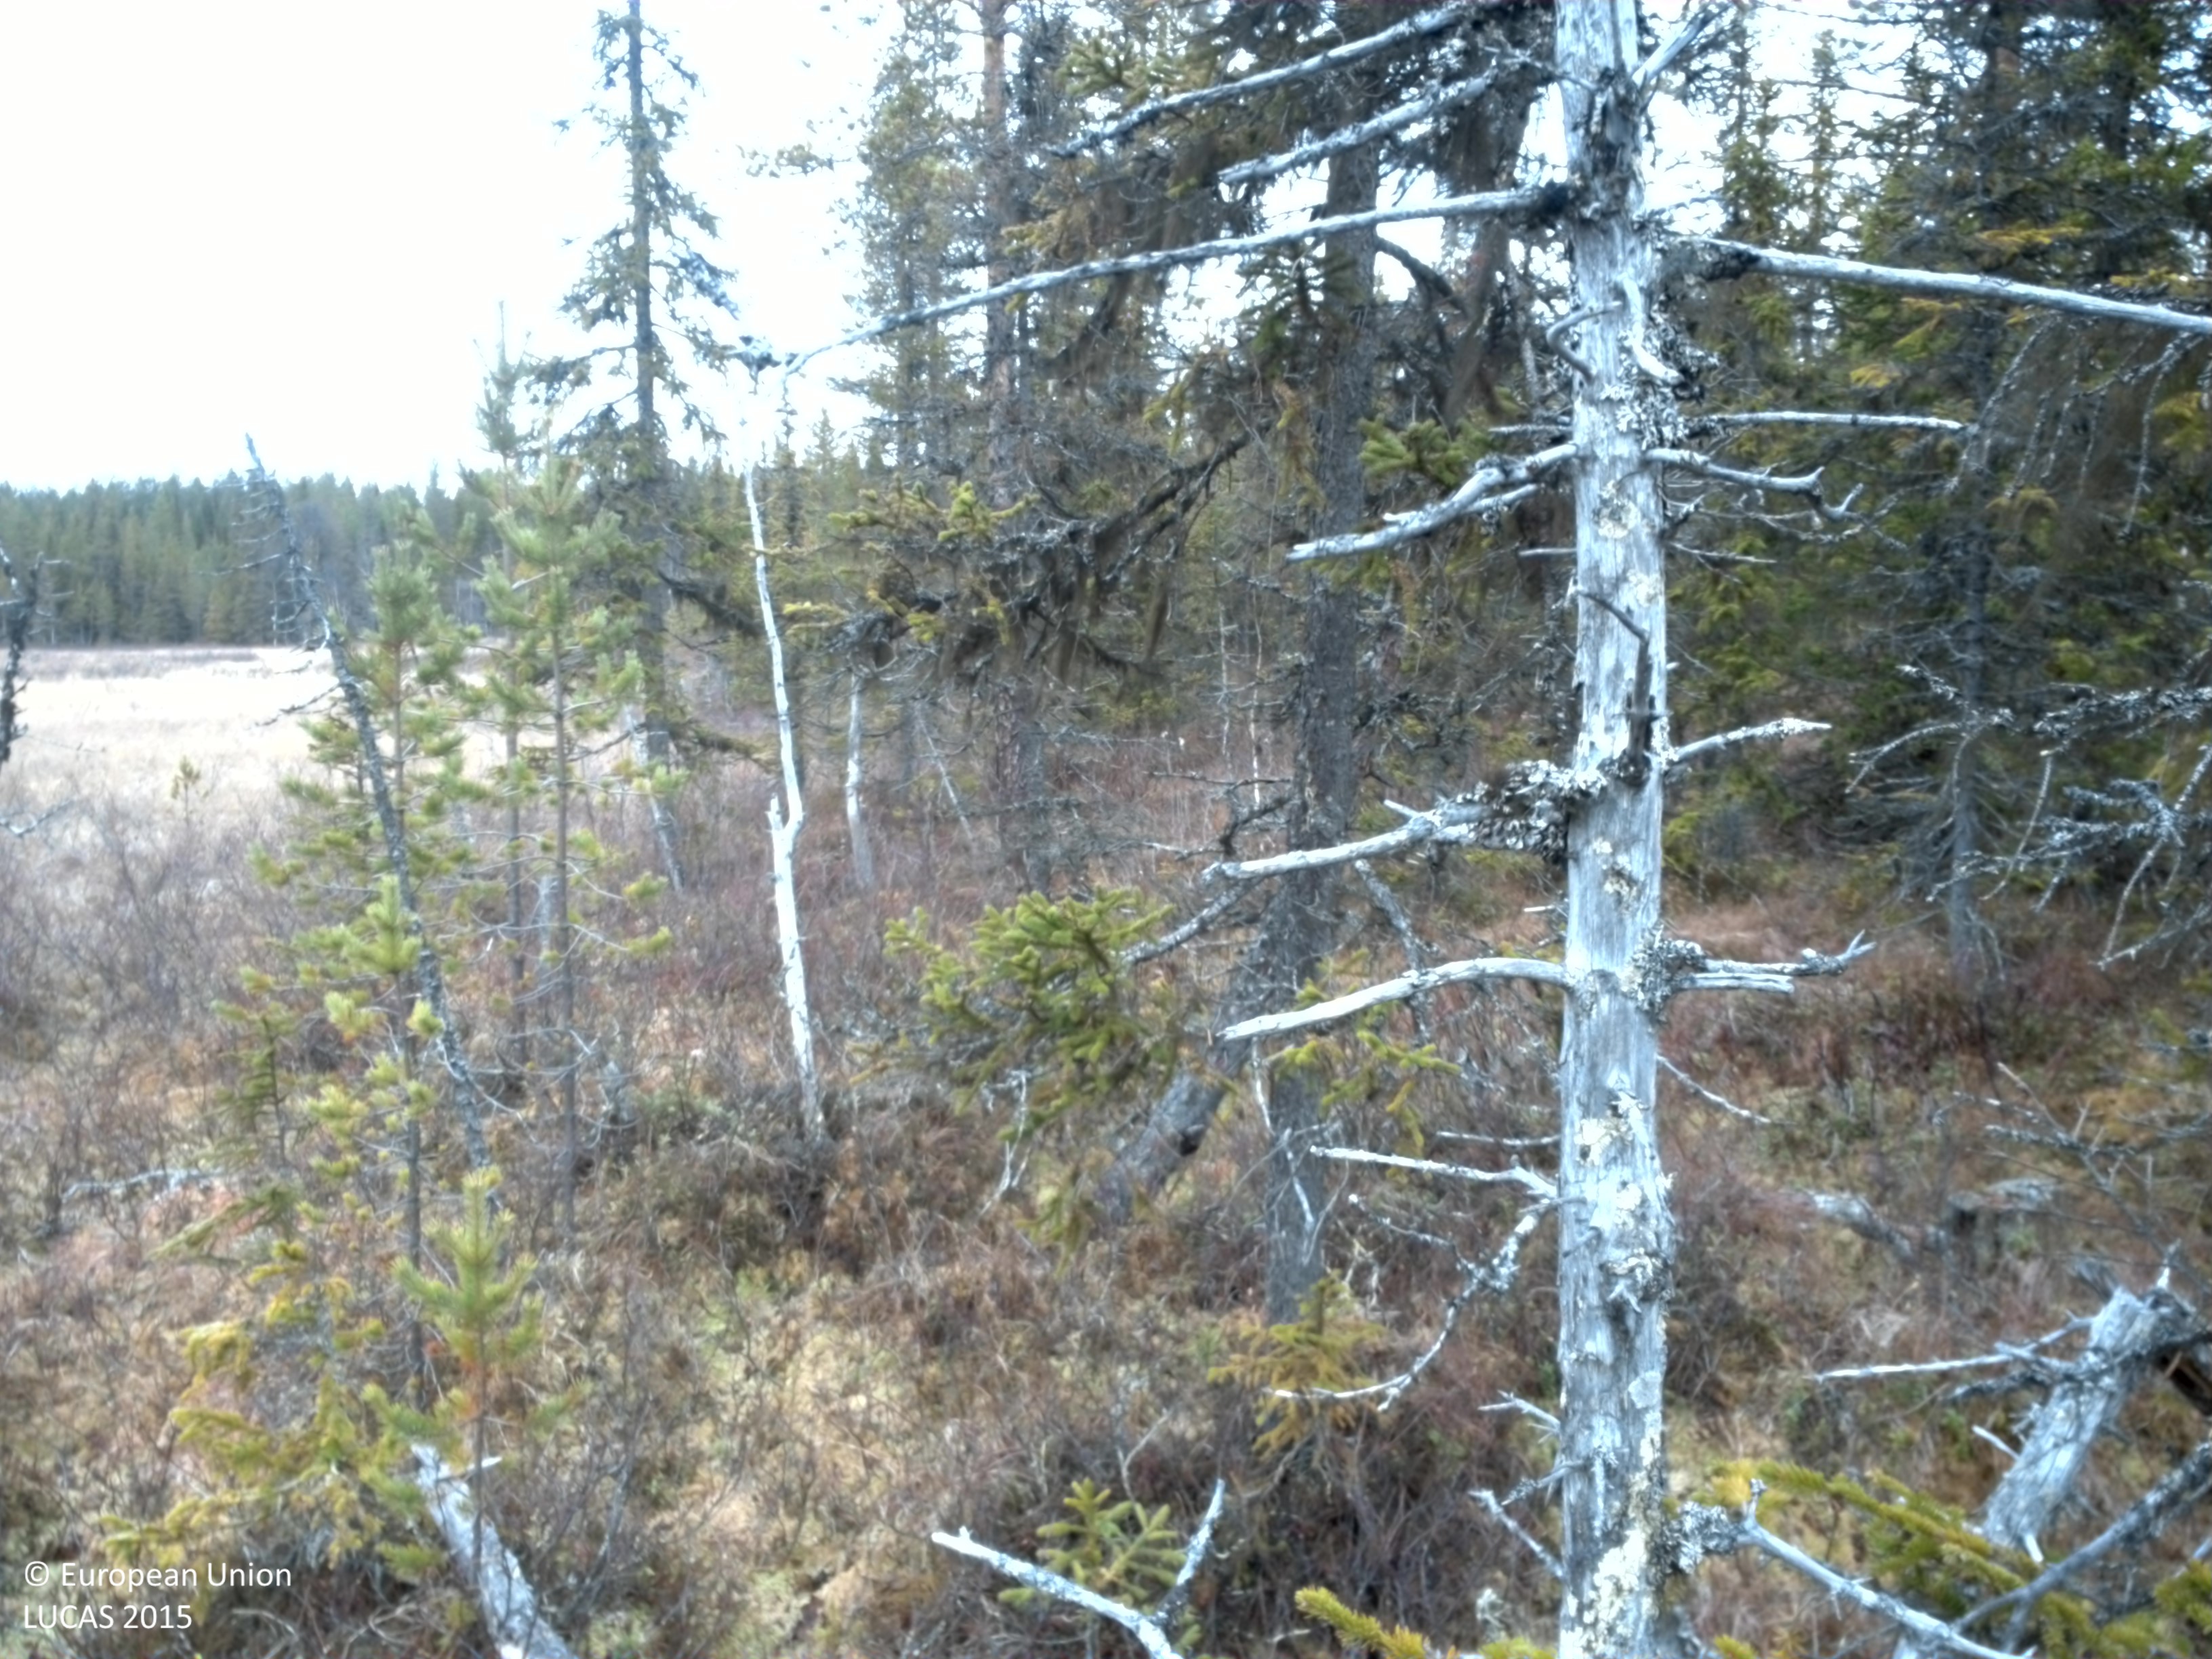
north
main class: Woodland
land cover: Spruce dominated coniferous woodland
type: boreal forest
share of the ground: 25 - 50 %
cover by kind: shrubs 35 %, lichens and mosses 30 %, coniferous forest trees 25 %, herbaceous plants 10 %
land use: Forestry
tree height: > 5 m
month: October
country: SE
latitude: 64.5414
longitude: 16.8268
